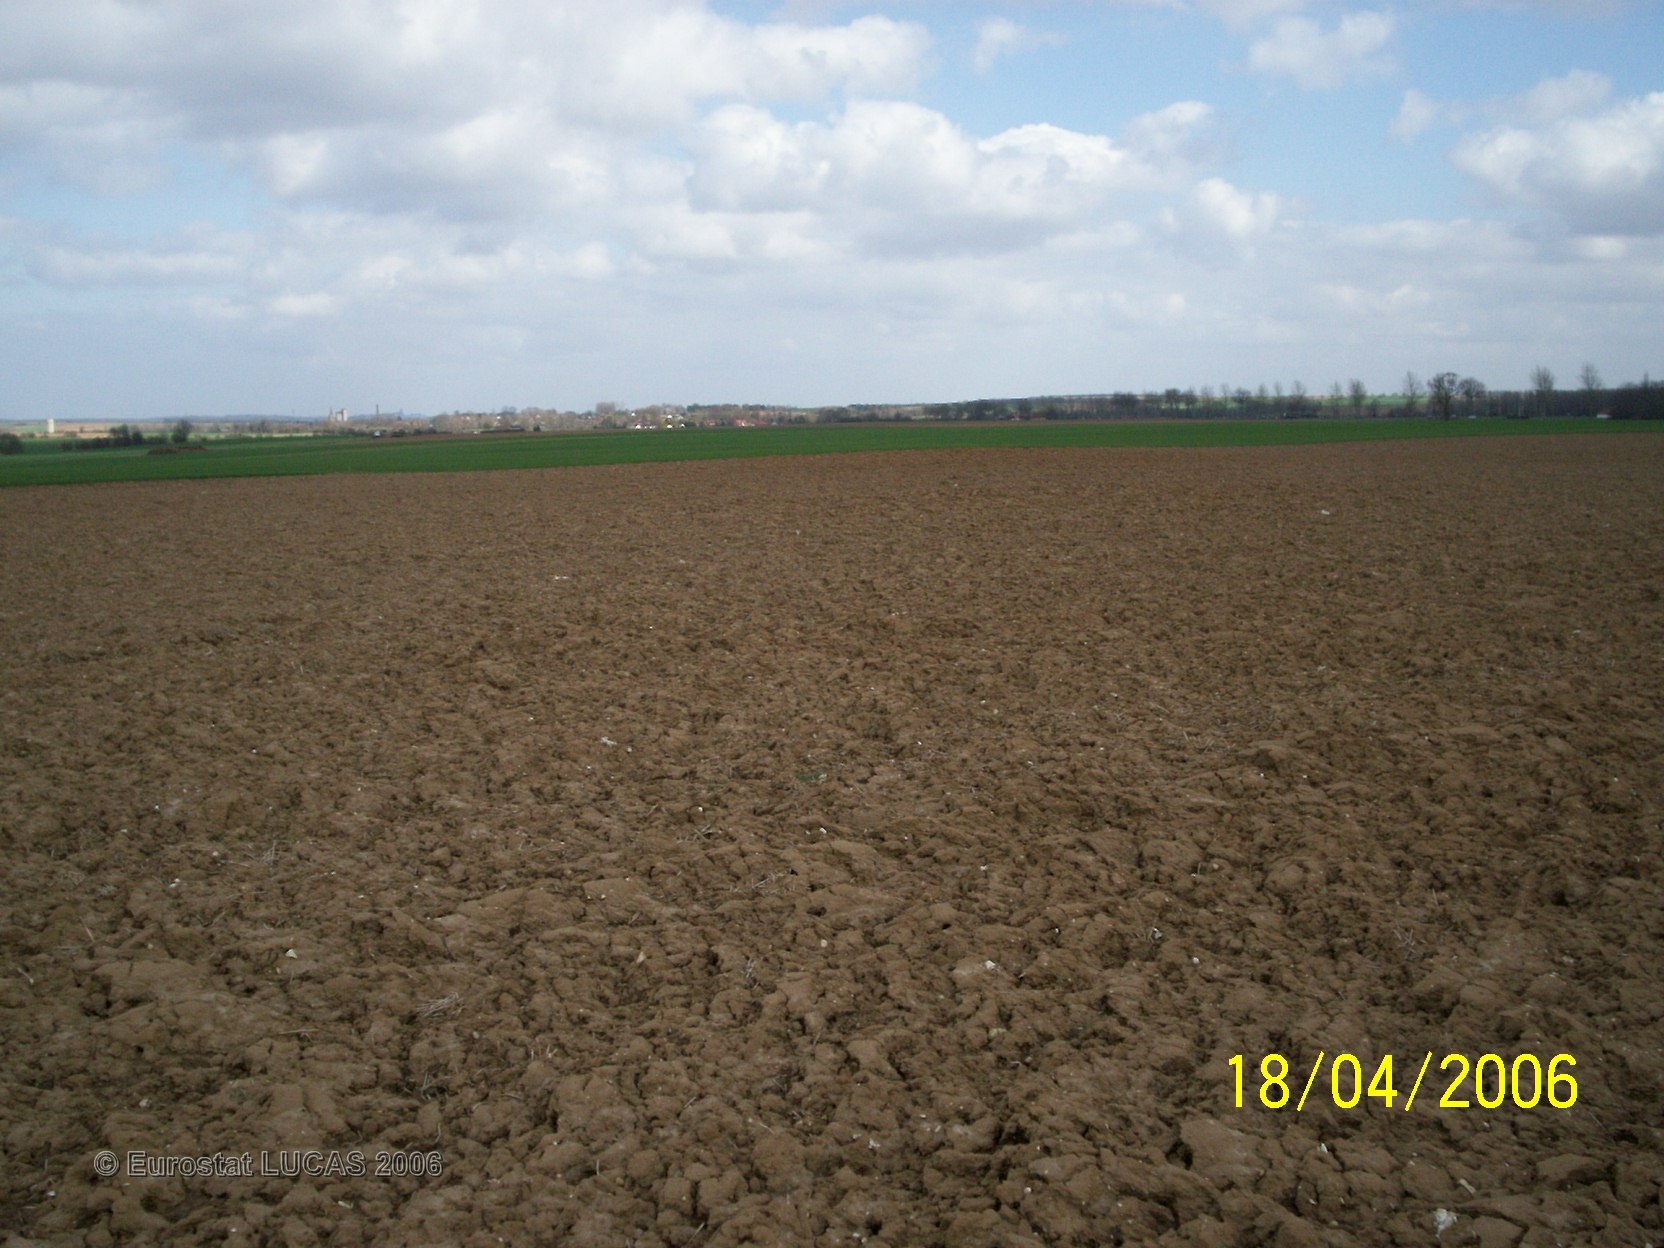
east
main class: Cropland
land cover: Maize
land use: Agriculture (excluding fallow land and kitchen gardens)
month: June
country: FR
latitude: 50.3540
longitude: 2.5244
